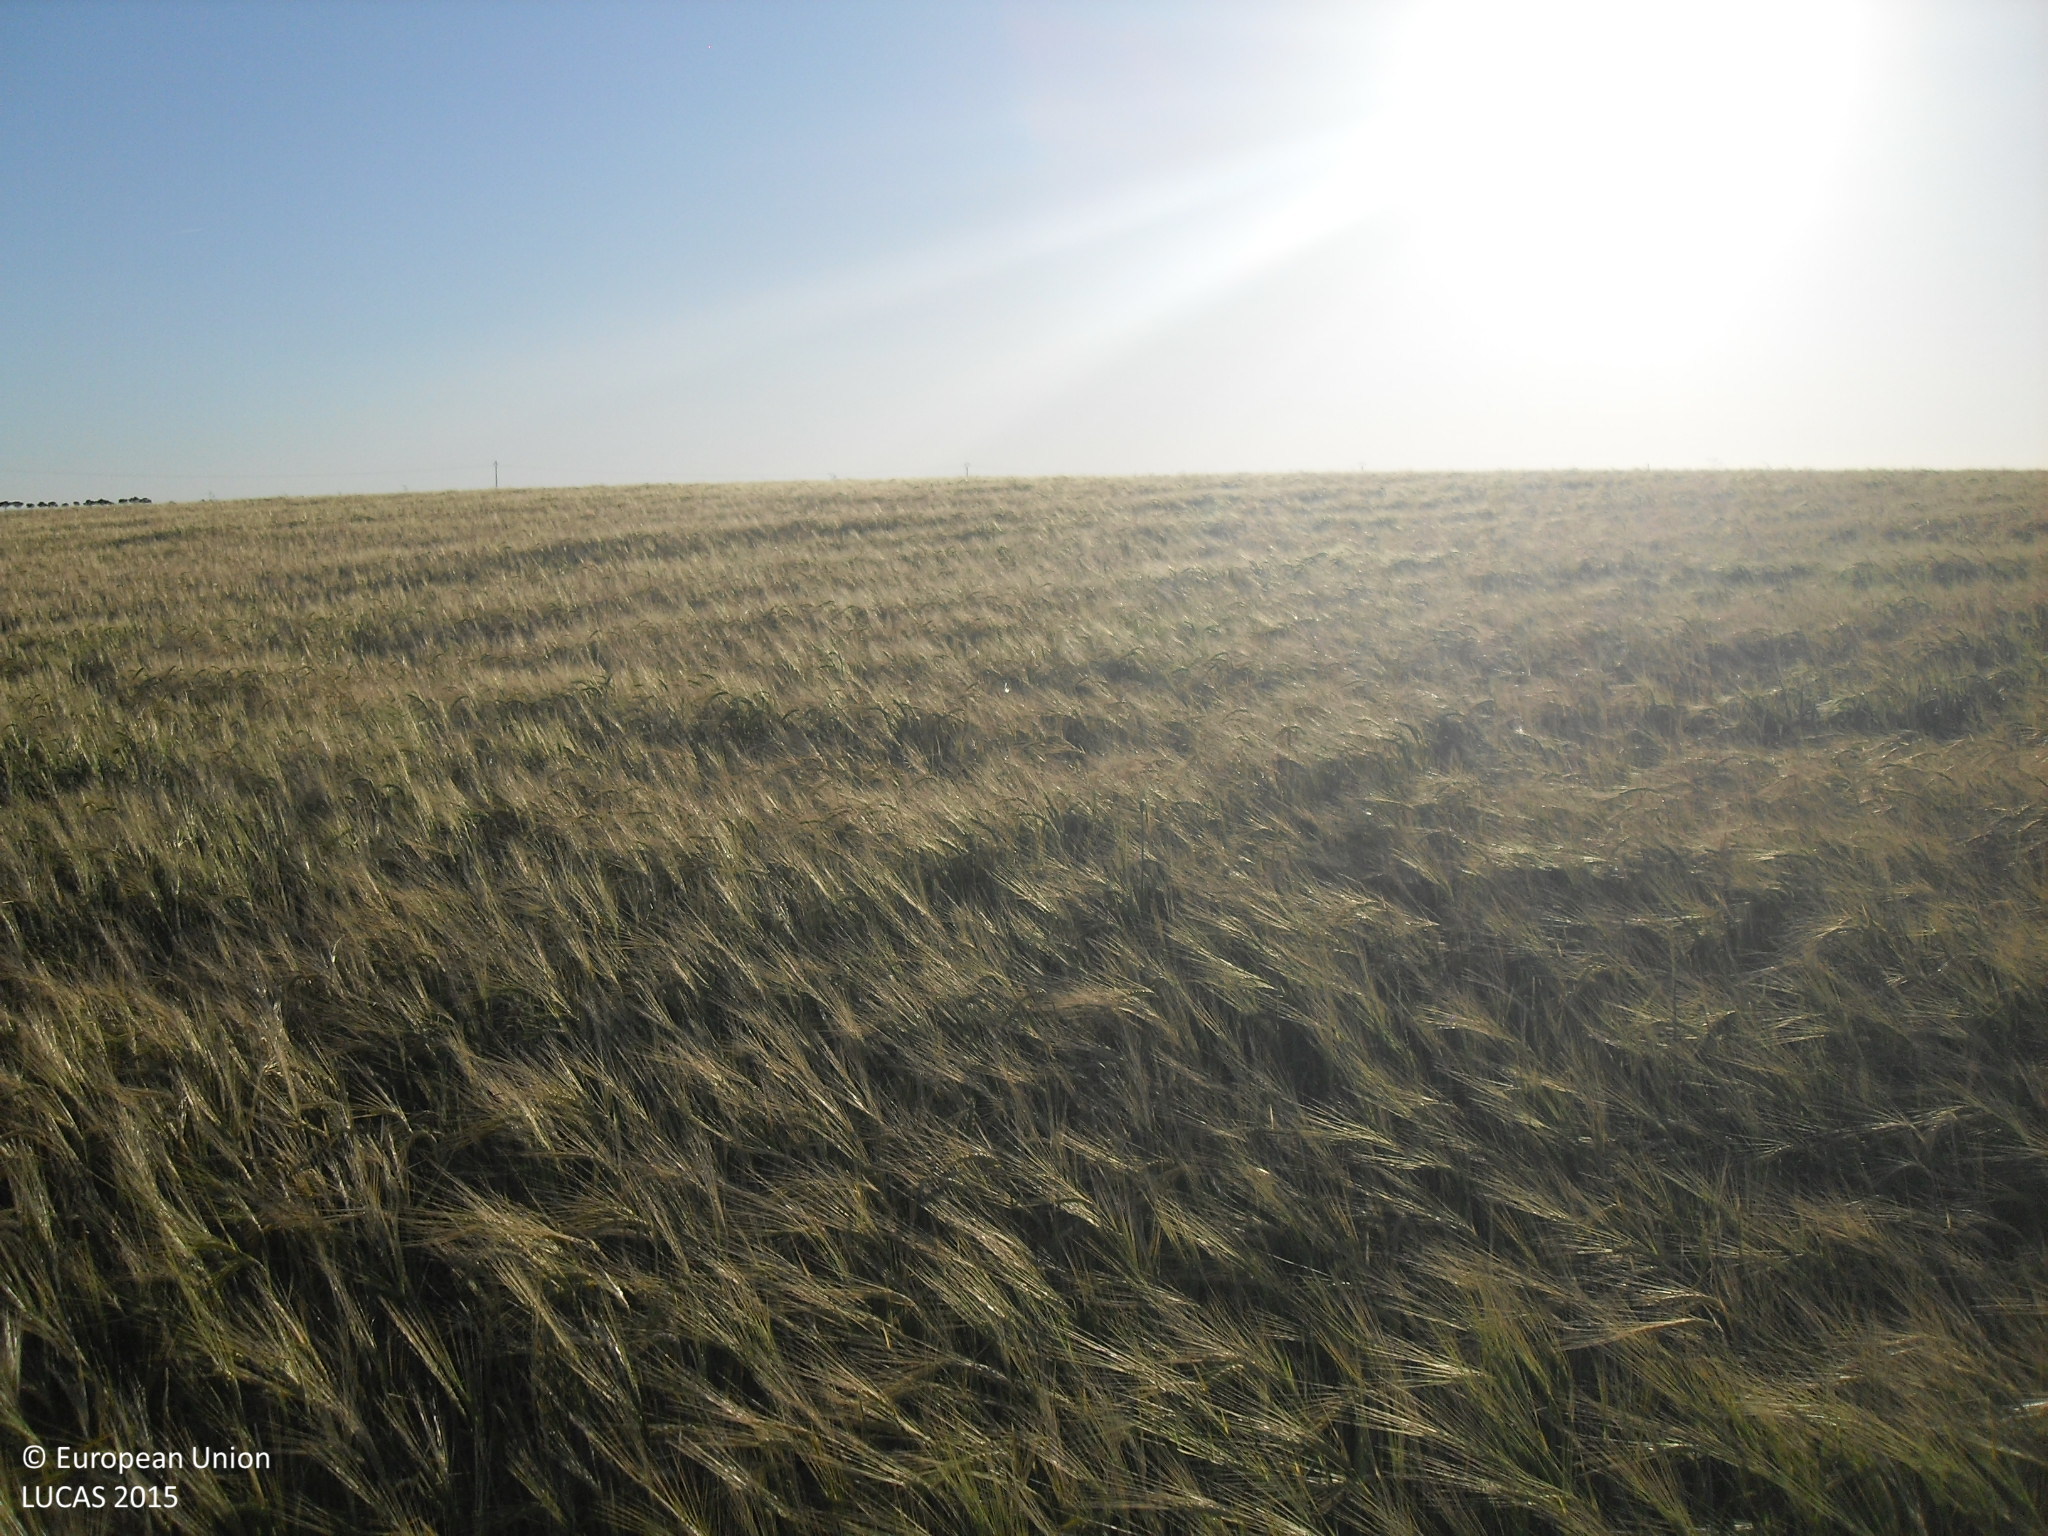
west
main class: Cropland
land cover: Barley
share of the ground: > 75 %
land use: Agriculture (excluding fallow land and kitchen gardens)
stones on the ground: 25 - 50 %
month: May
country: ES
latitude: 41.0659
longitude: -5.3891
